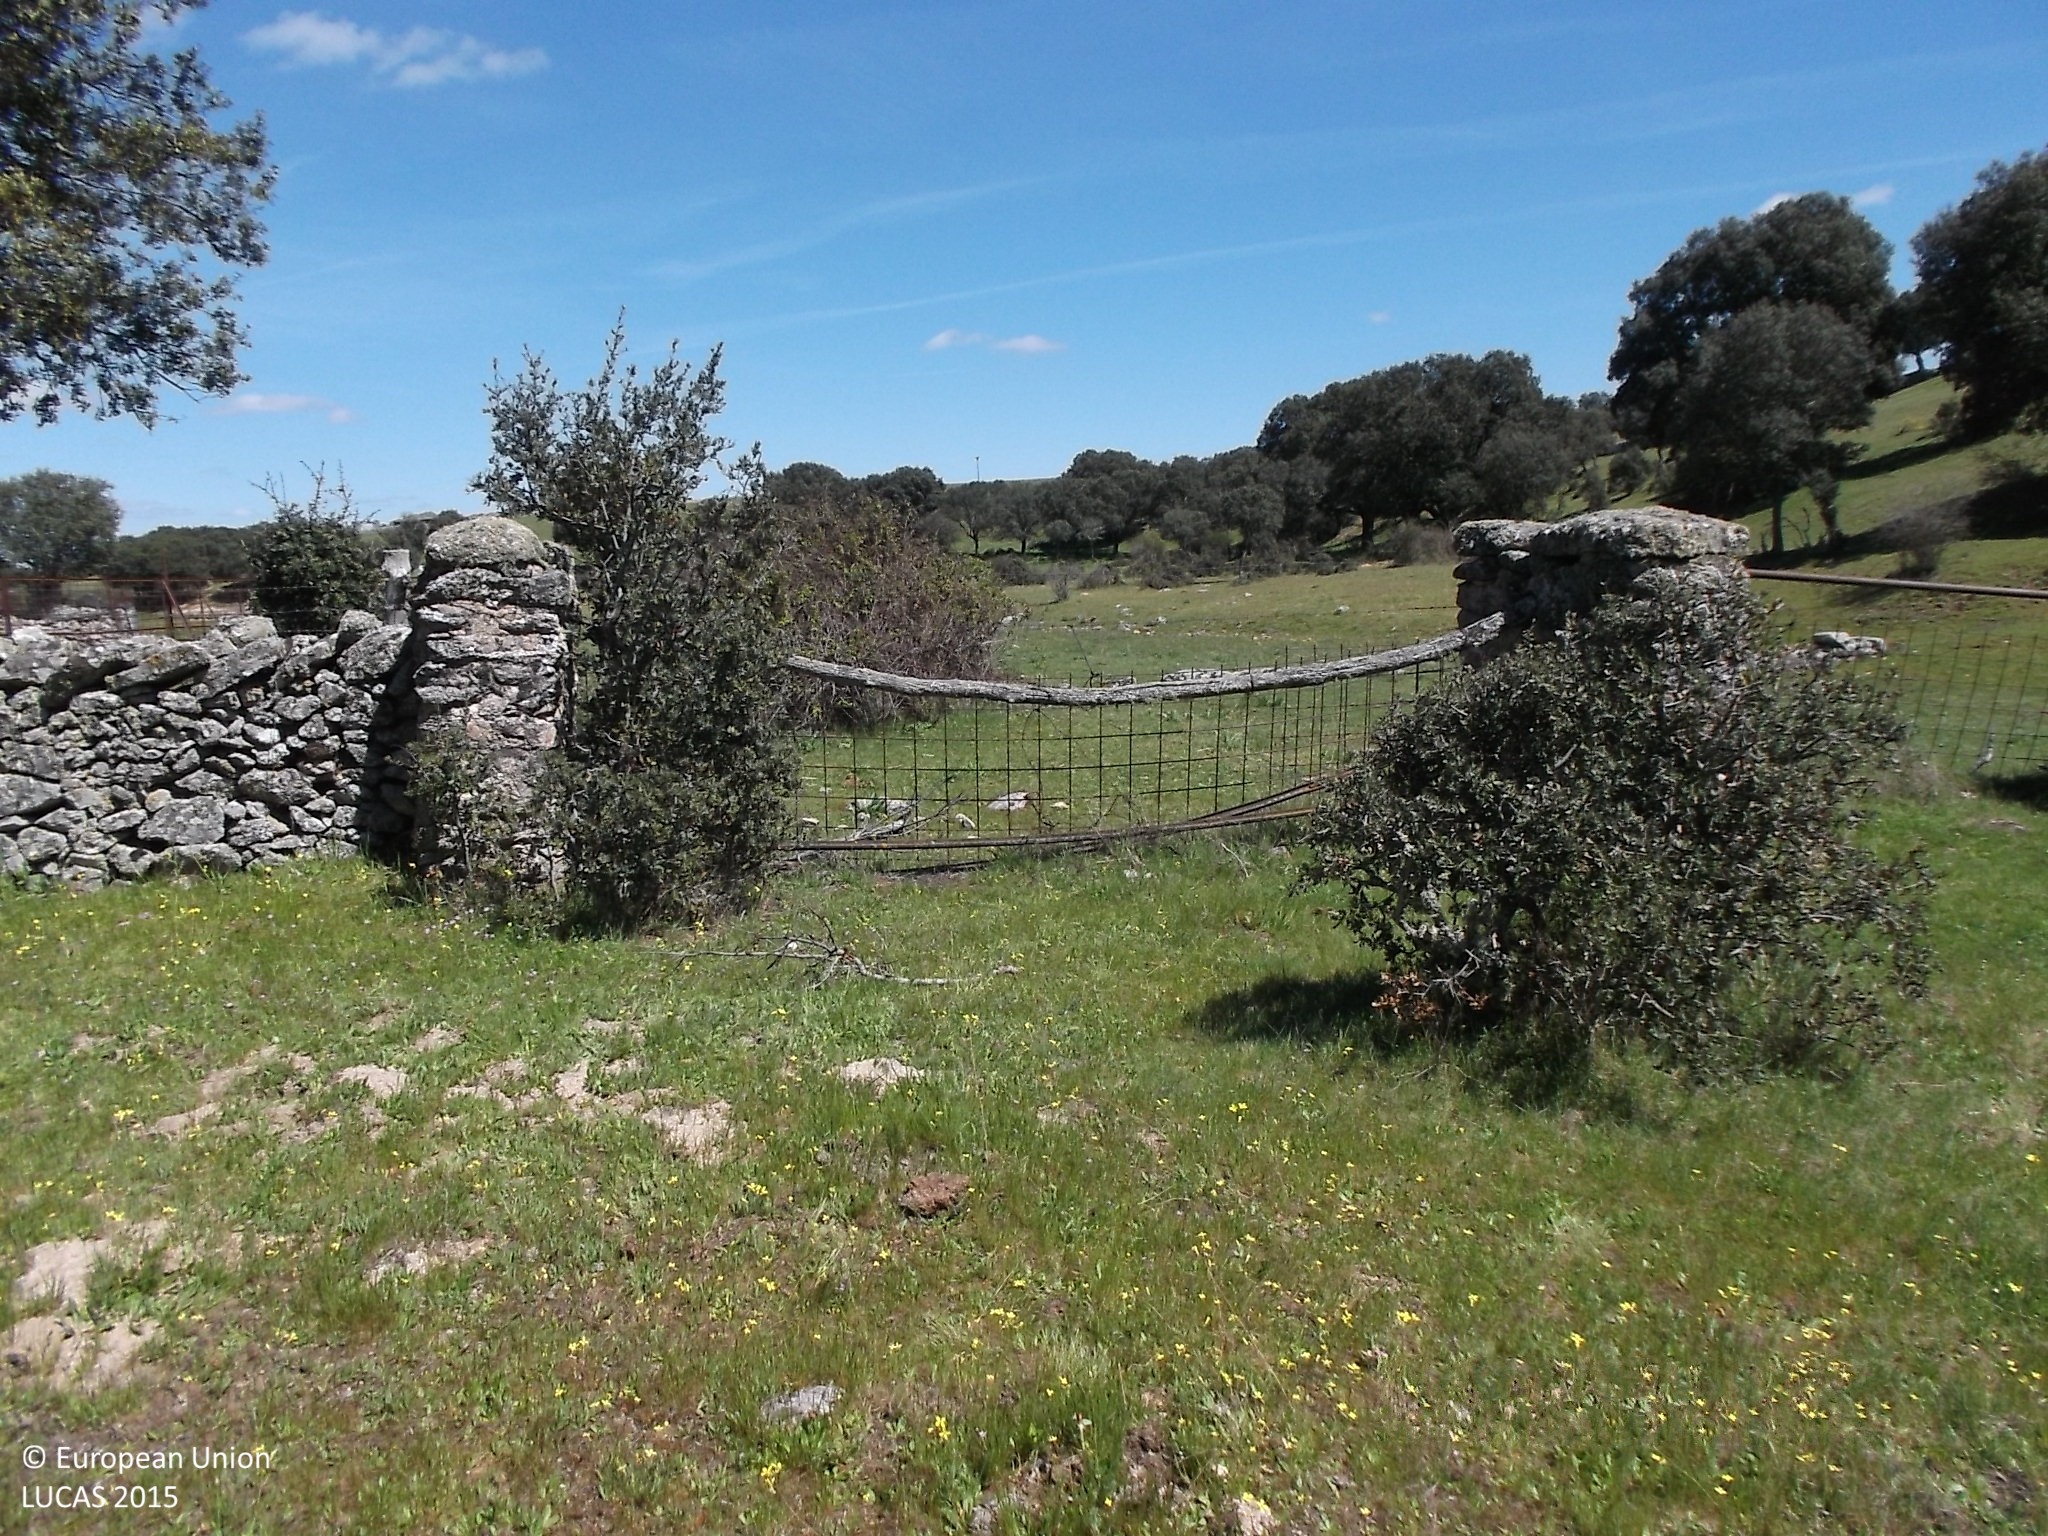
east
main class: Woodland
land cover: Broadleaved woodland
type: broadleaved evergreen forest
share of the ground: 25 - 50 %
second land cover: Shrubland without tree cover
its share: 25 - 50 %
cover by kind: herbaceous plants 45 %, broadleaved forest trees 30 %, shrubs 25 %
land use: Forestry
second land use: Agriculture (excluding fallow land and kitchen gardens)
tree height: < 5 m
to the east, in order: Broadleaved woodland; Shrubland without tree cover; Fences; Grassland without tree/shrub cover; Broadleaved woodland; Grassland without tree/shrub cover
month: April
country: ES
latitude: 40.9727
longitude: -5.9719
